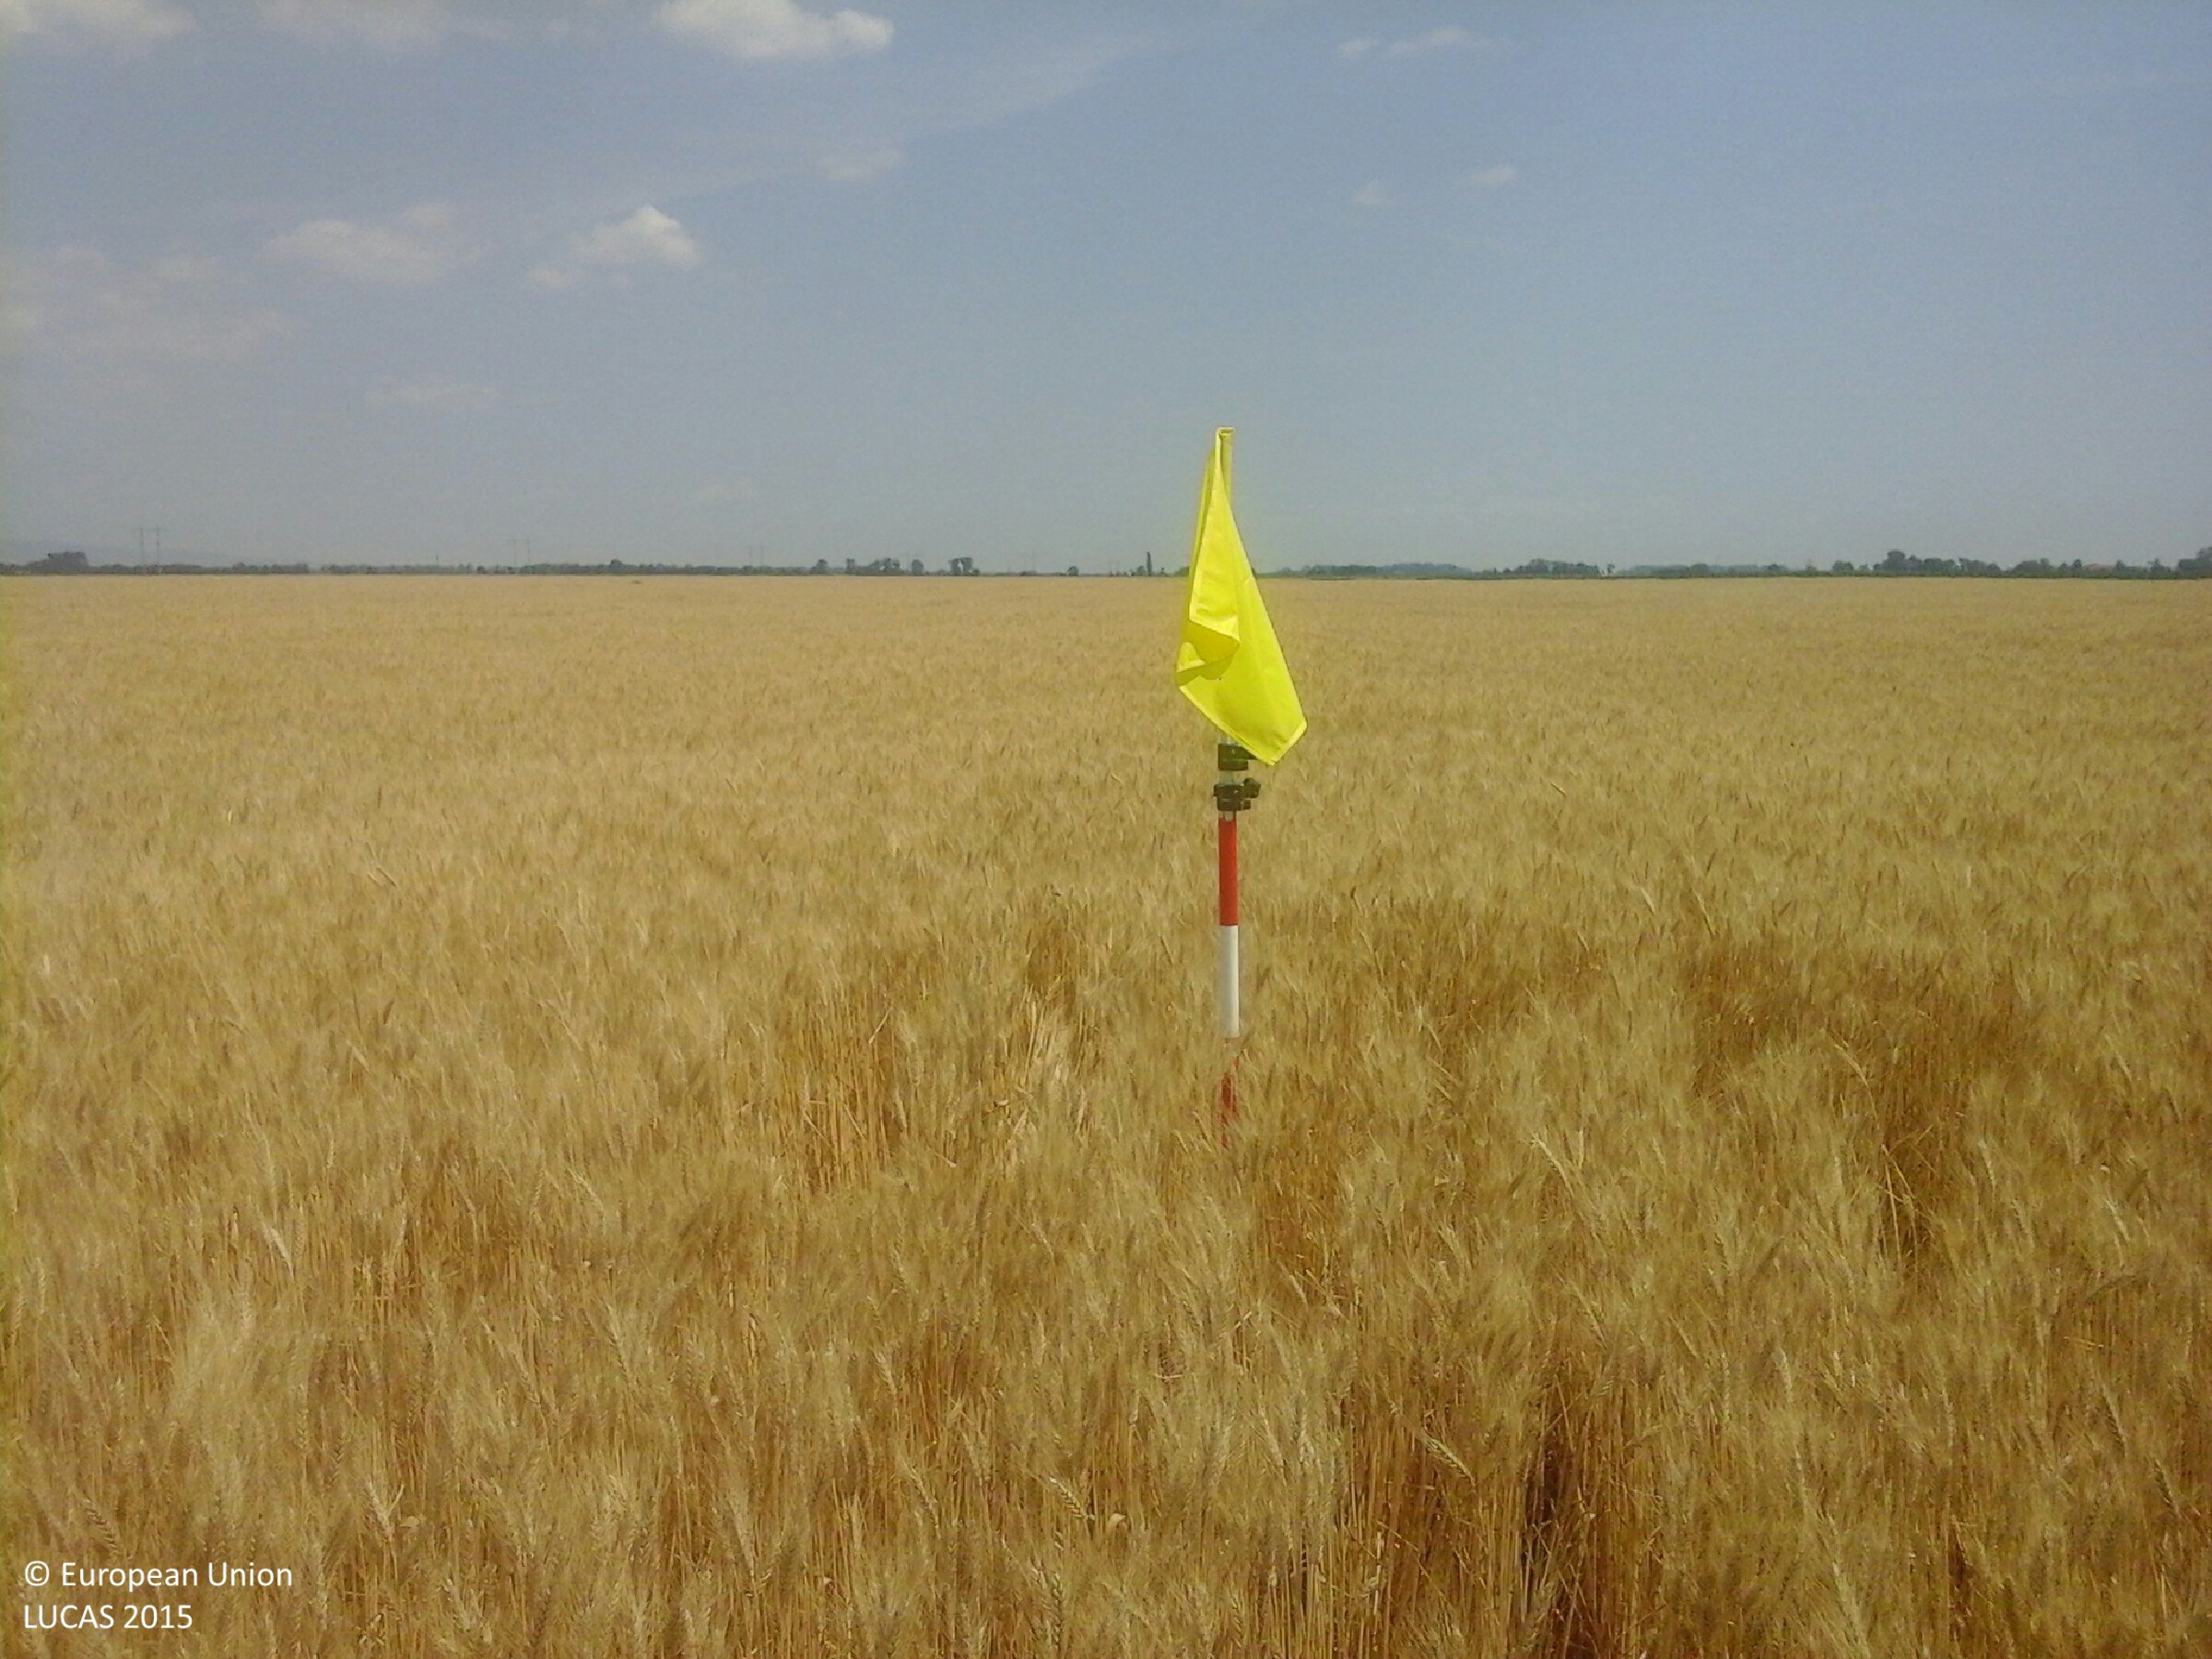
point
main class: Cropland
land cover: Barley
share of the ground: > 75 %
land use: Agriculture (excluding fallow land and kitchen gardens)
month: July
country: HU
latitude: 47.7489
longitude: 20.5835
